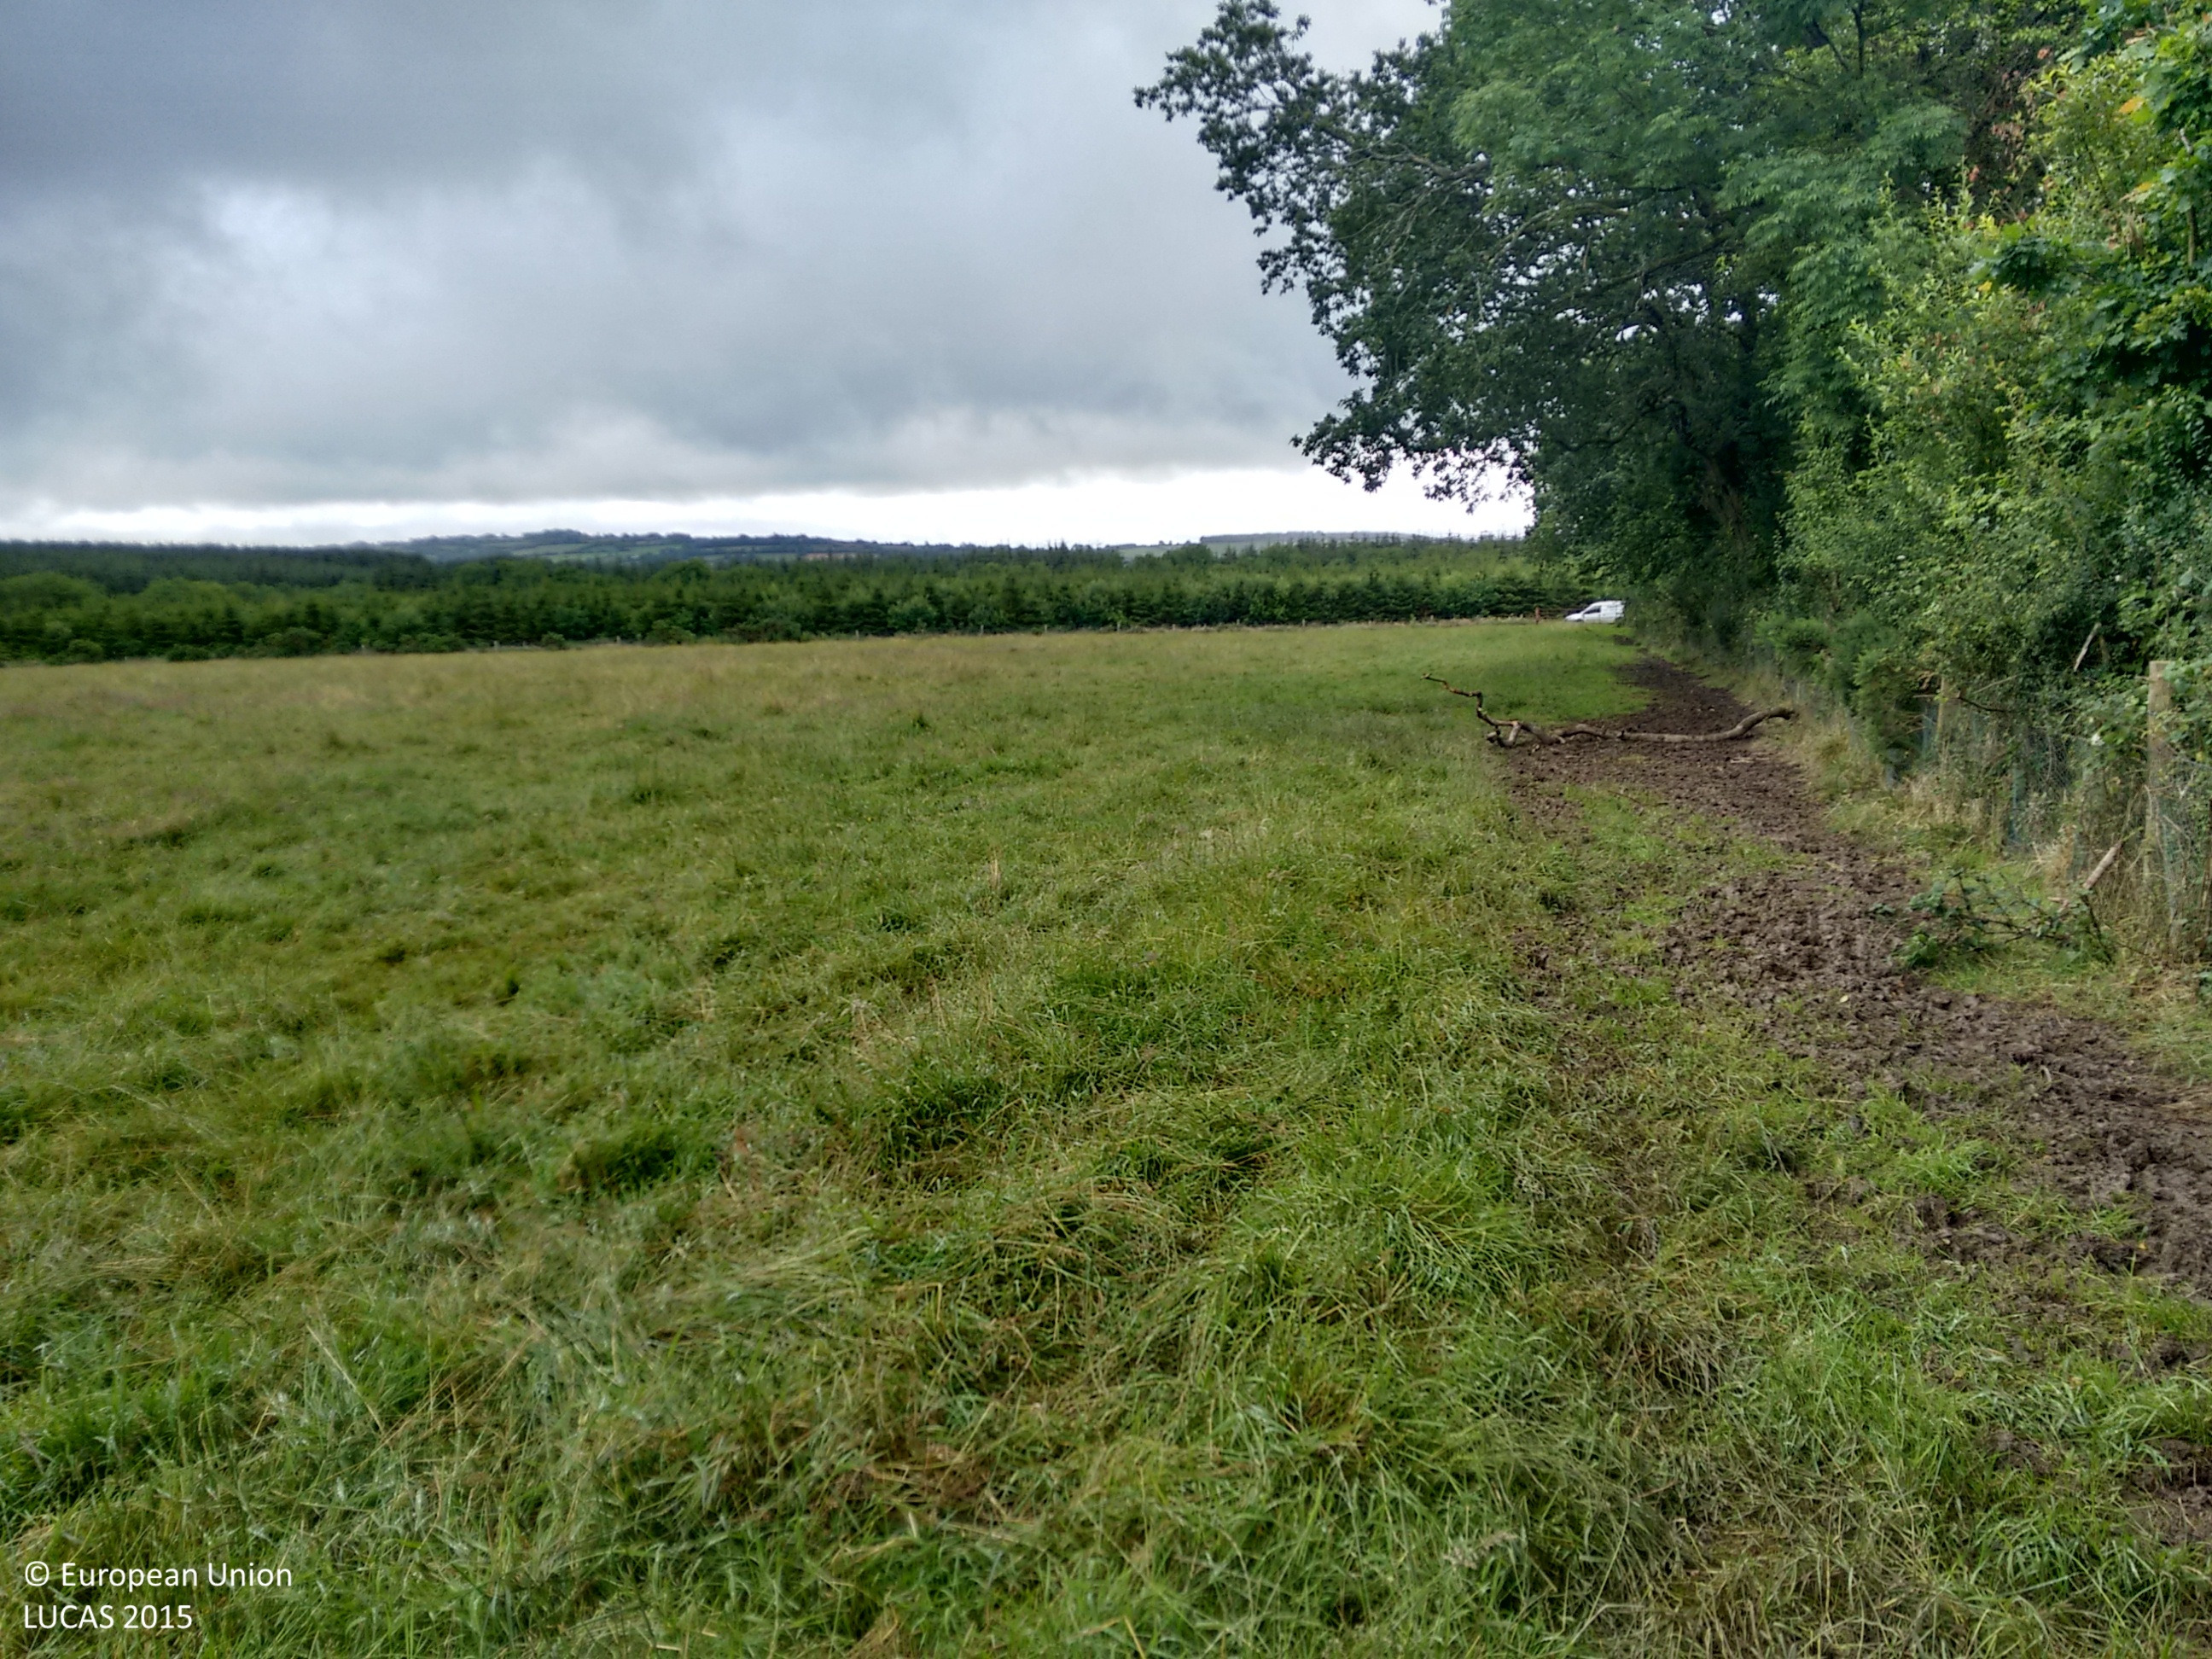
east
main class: Grassland
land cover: Grassland without tree/shrub cover
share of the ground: > 75 %
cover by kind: herbaceous plants 100 %
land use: Agriculture (excluding fallow land and kitchen gardens)
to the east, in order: Grassland without tree/shrub cover; Broadleaved woodland; Fences; Grassland without tree/shrub cover; Fences; Tracks; Grass margins; Fences; Spruce dominated coniferous woodland
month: July
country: IE
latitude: 52.6171
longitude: -7.4532
